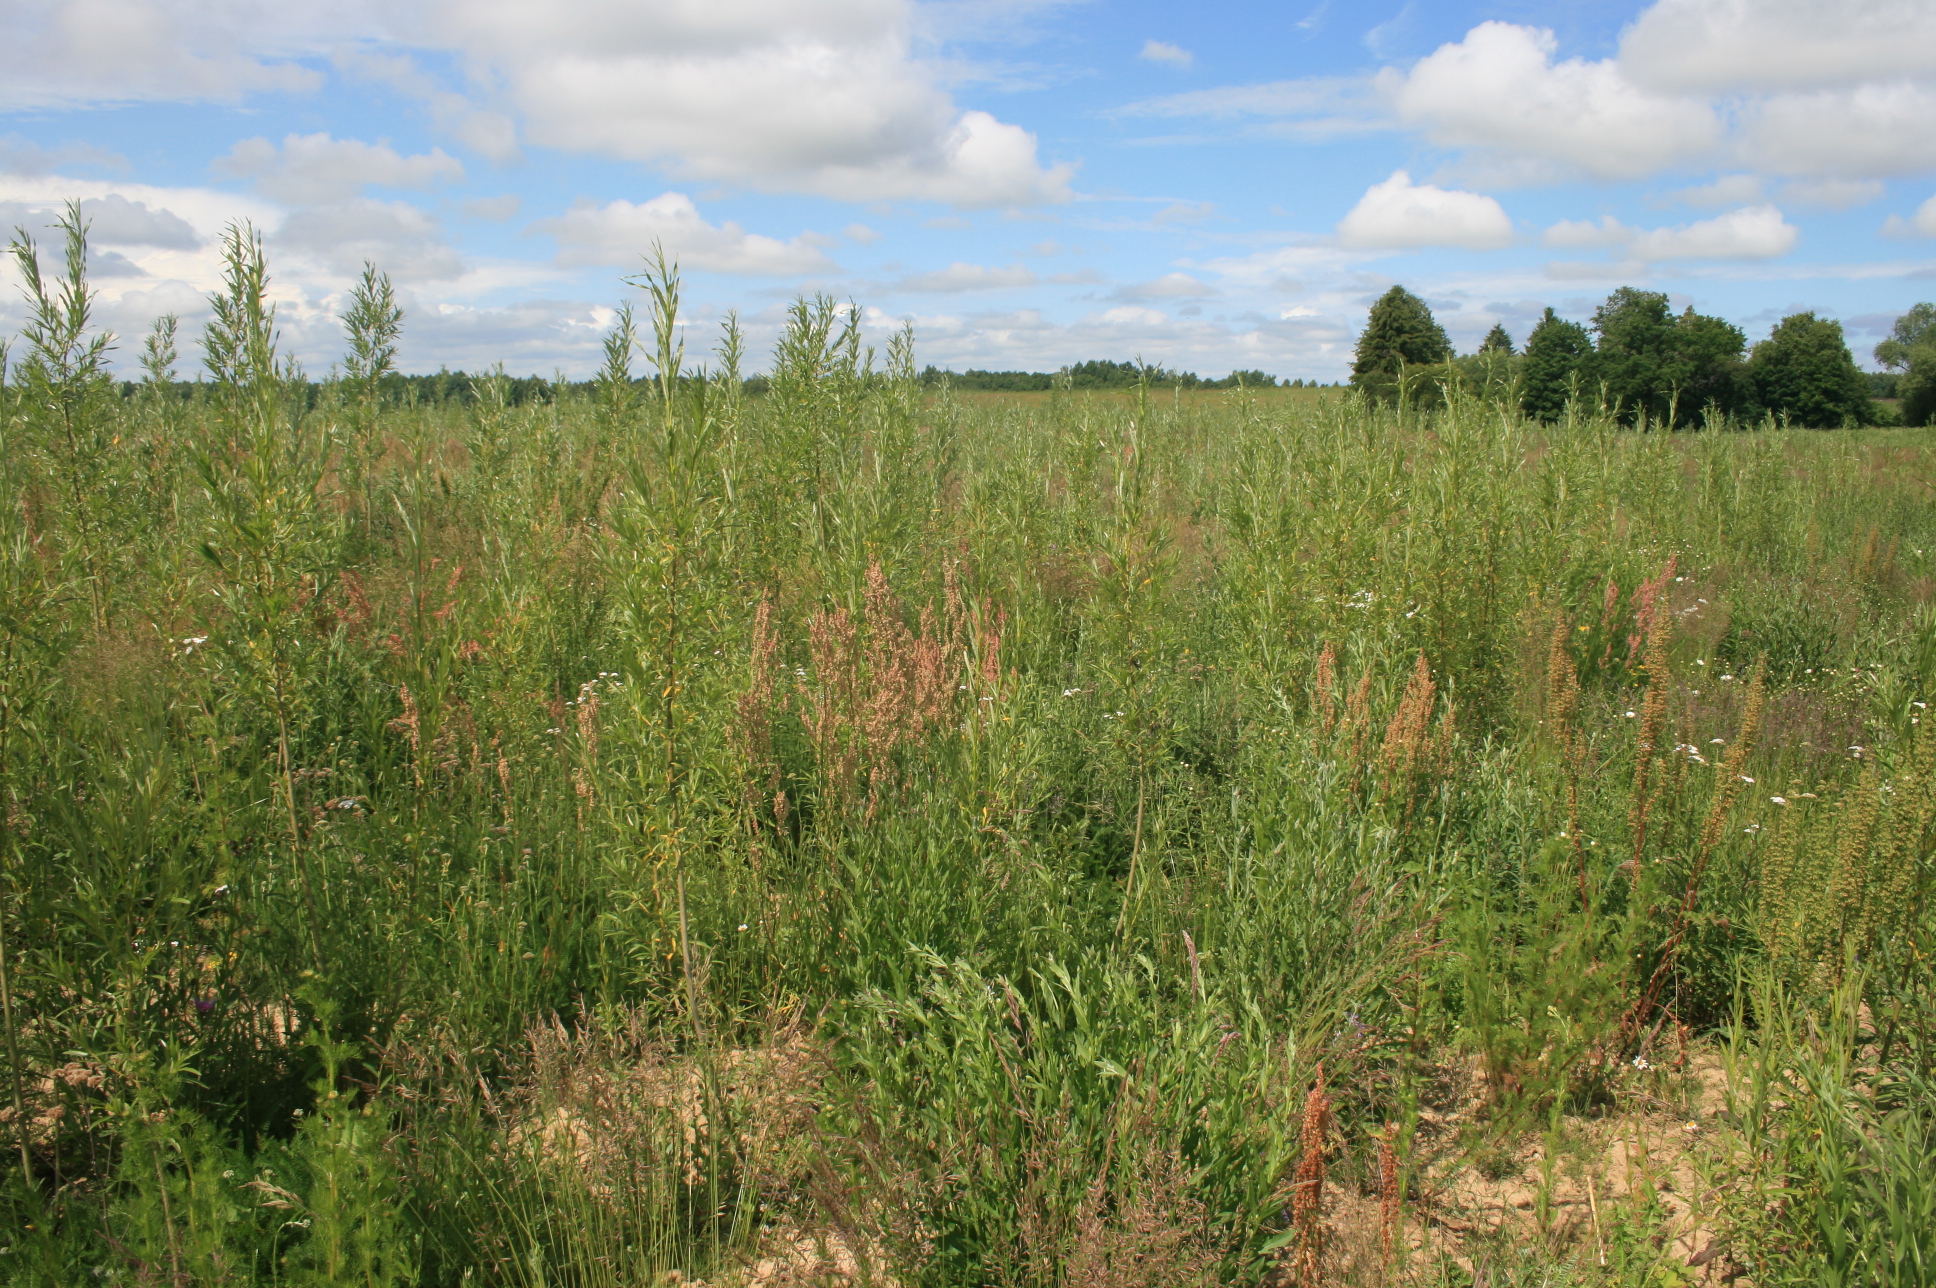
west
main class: Shrubland
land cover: Shrubland without tree cover
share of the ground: 50 - 75 %
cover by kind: shrubs 60 %, herbaceous plants 40 %
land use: Abandoned areas
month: June
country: LT
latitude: 55.2496
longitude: 22.0894
